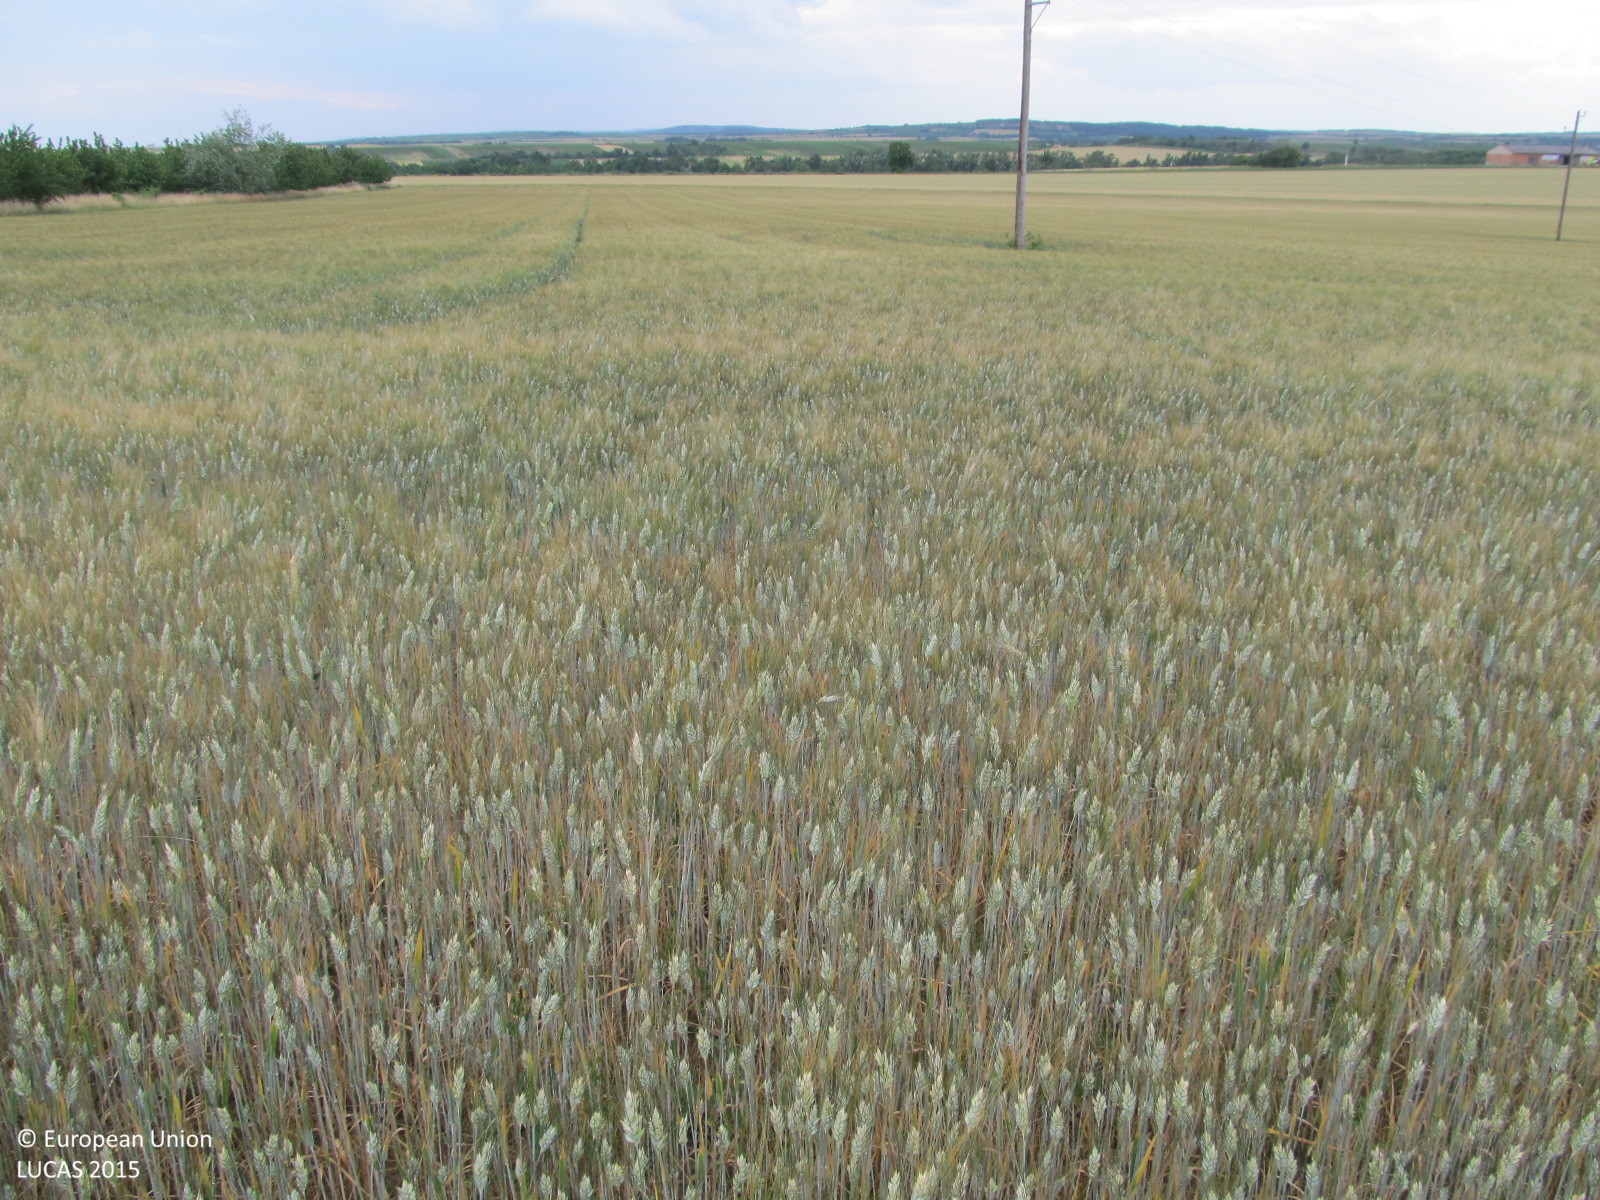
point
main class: Cropland
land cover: Durum wheat
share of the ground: > 75 %
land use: Agriculture (excluding fallow land and kitchen gardens)
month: June
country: AT
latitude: 48.7141
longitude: 15.9164
